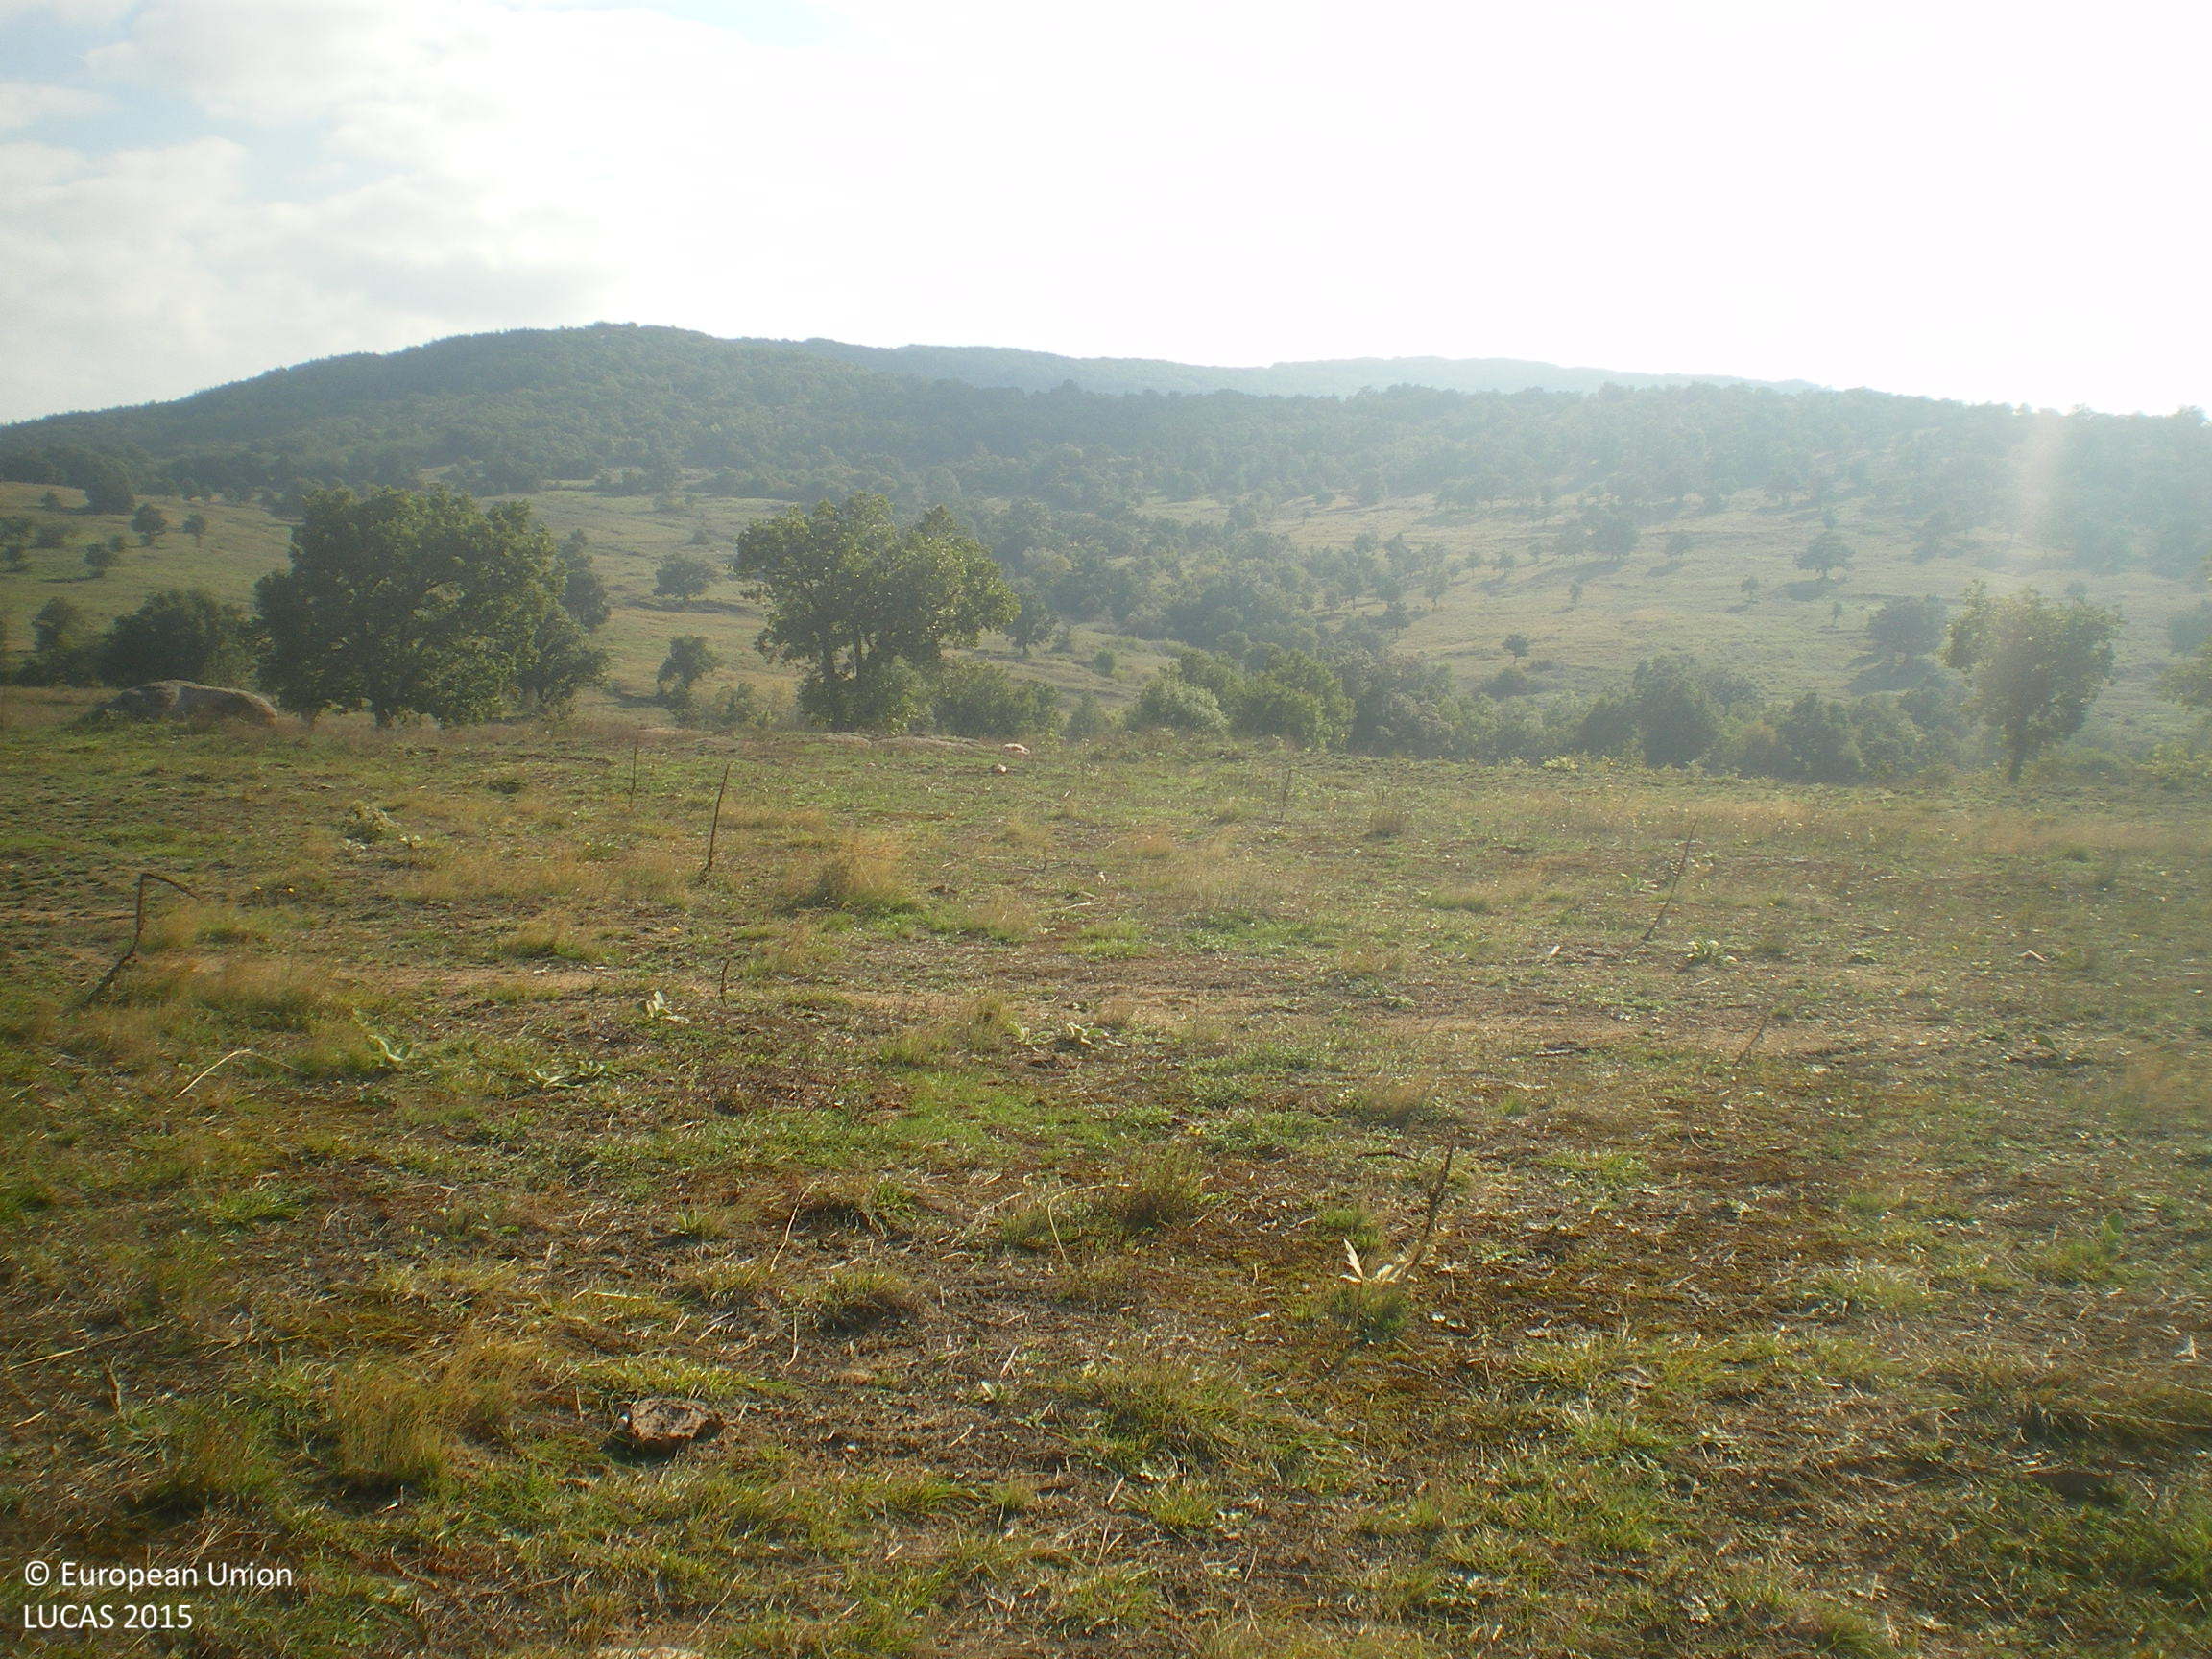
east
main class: Grassland
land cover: Grassland without tree/shrub cover
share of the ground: > 75 %
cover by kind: herbaceous plants 100 %
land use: Agriculture (excluding fallow land and kitchen gardens)
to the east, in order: Grassland without tree/shrub cover; Grassland with sparse tree/shrub cover; Grassland without tree/shrub cover; Grassland with sparse tree/shrub cover; Grassland without tree/shrub cover; Broadleaved woodland
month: October
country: BG
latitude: 41.9982
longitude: 26.2202
